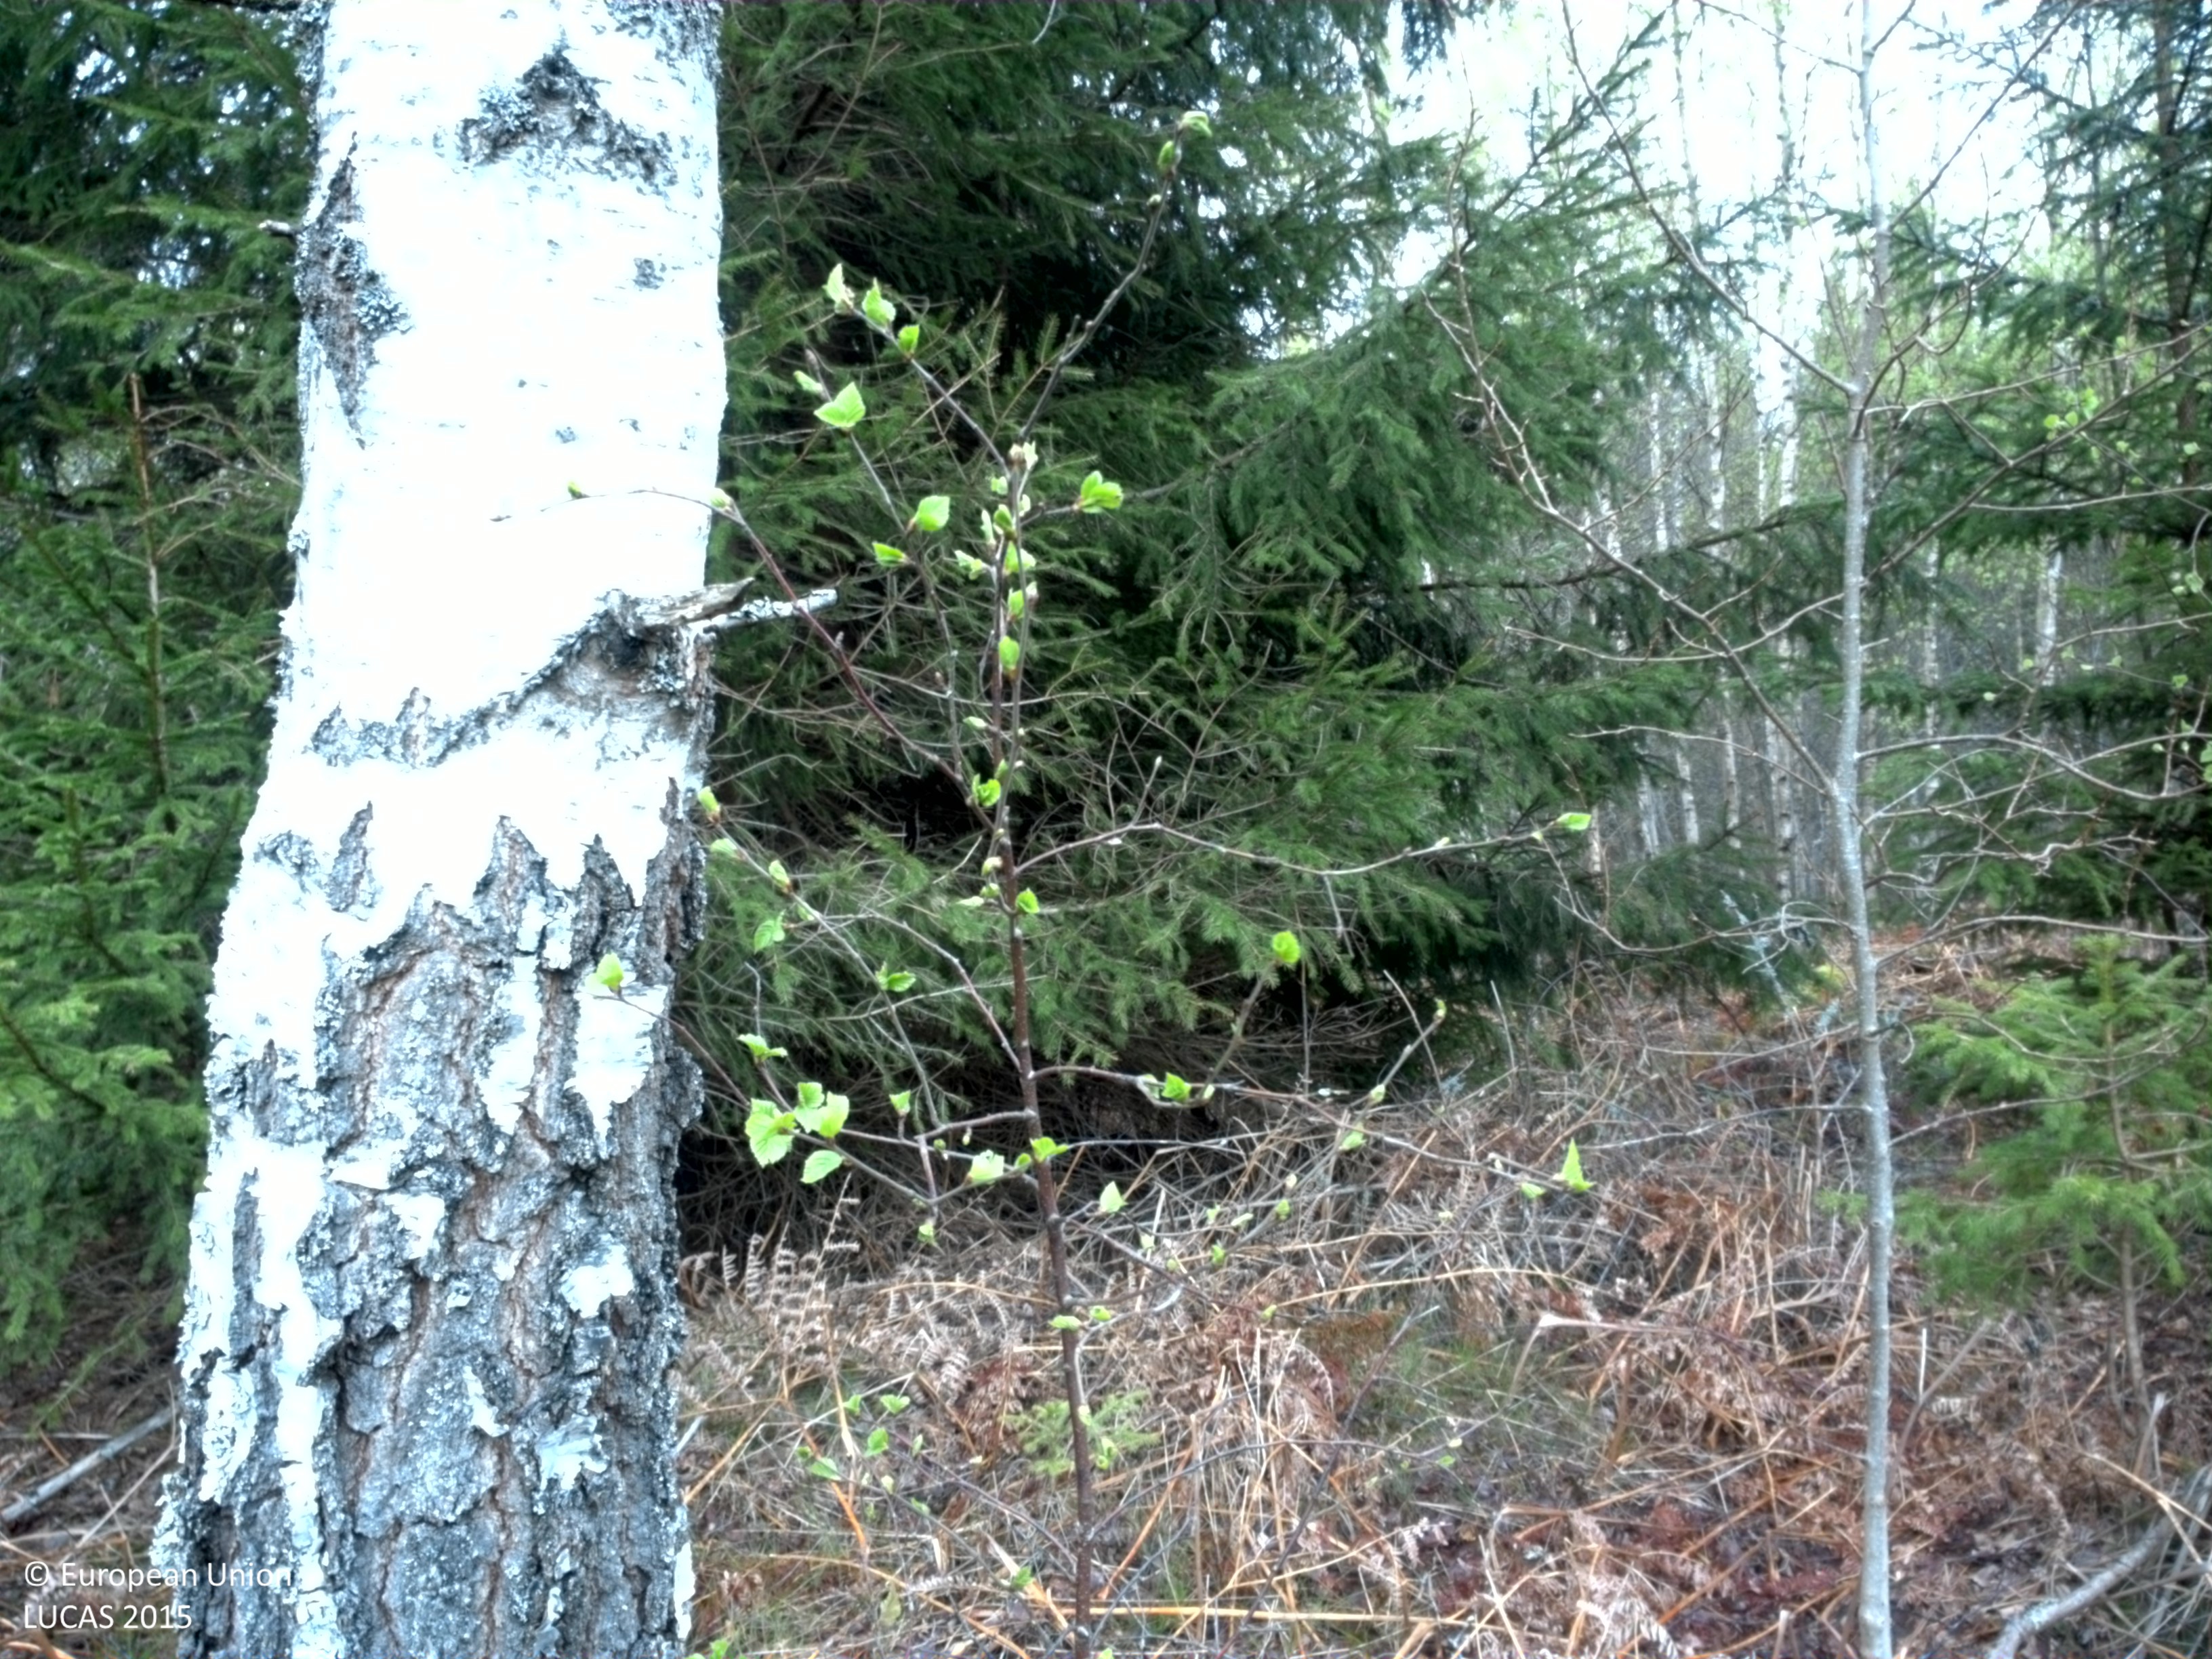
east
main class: Woodland
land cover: Spruce dominated mixed woodland
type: boreal forest
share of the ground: > 75 %
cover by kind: coniferous forest trees 40 %, broadleaved forest trees 40 %, herbaceous plants 10 %, lichens and mosses 10 %
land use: Forestry
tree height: > 5 m
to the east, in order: Grass margins; Spruce dominated mixed woodland; Ditches and canals; Spruce dominated coniferous woodland; Broadleaved woodland; Spruce dominated coniferous woodland; Shrubland with sparse tree cover
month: May
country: SE
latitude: 56.6462
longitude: 15.0698
